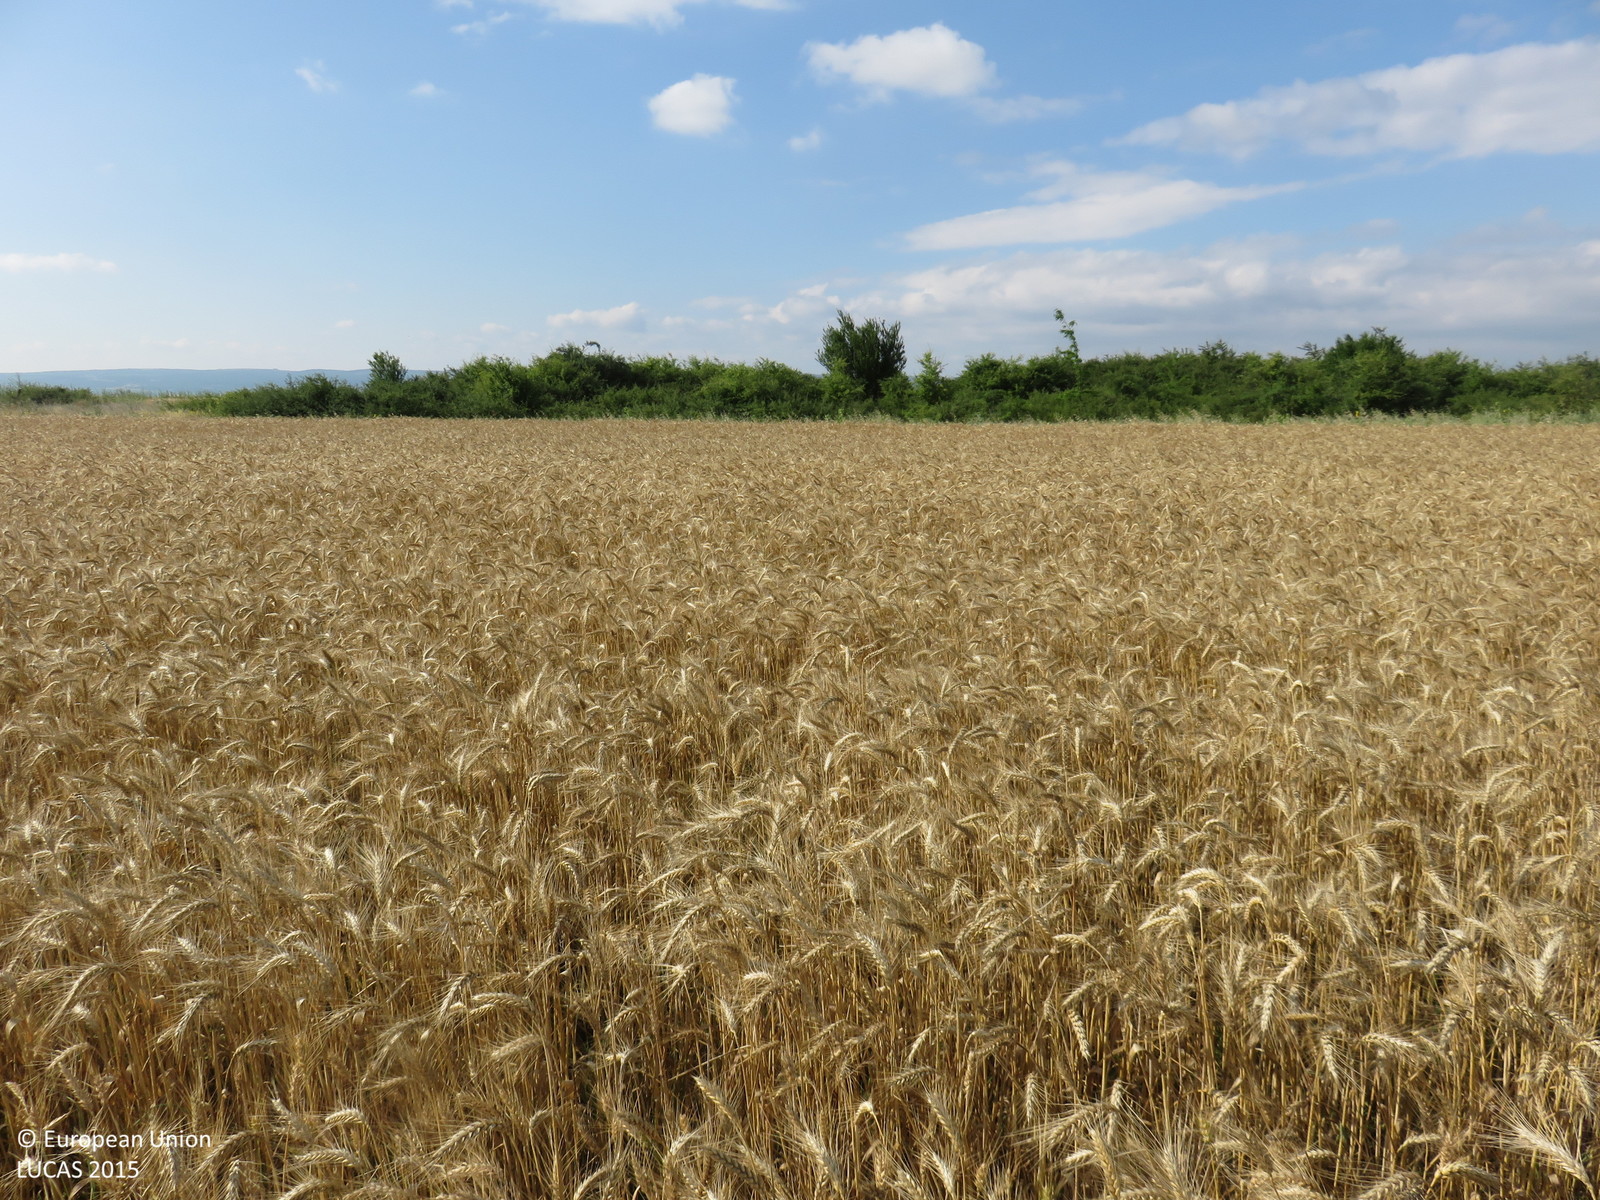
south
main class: Cropland
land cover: Common wheat
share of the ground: > 75 %
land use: Agriculture (excluding fallow land and kitchen gardens)
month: June
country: BG
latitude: 43.3292
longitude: 24.9793
